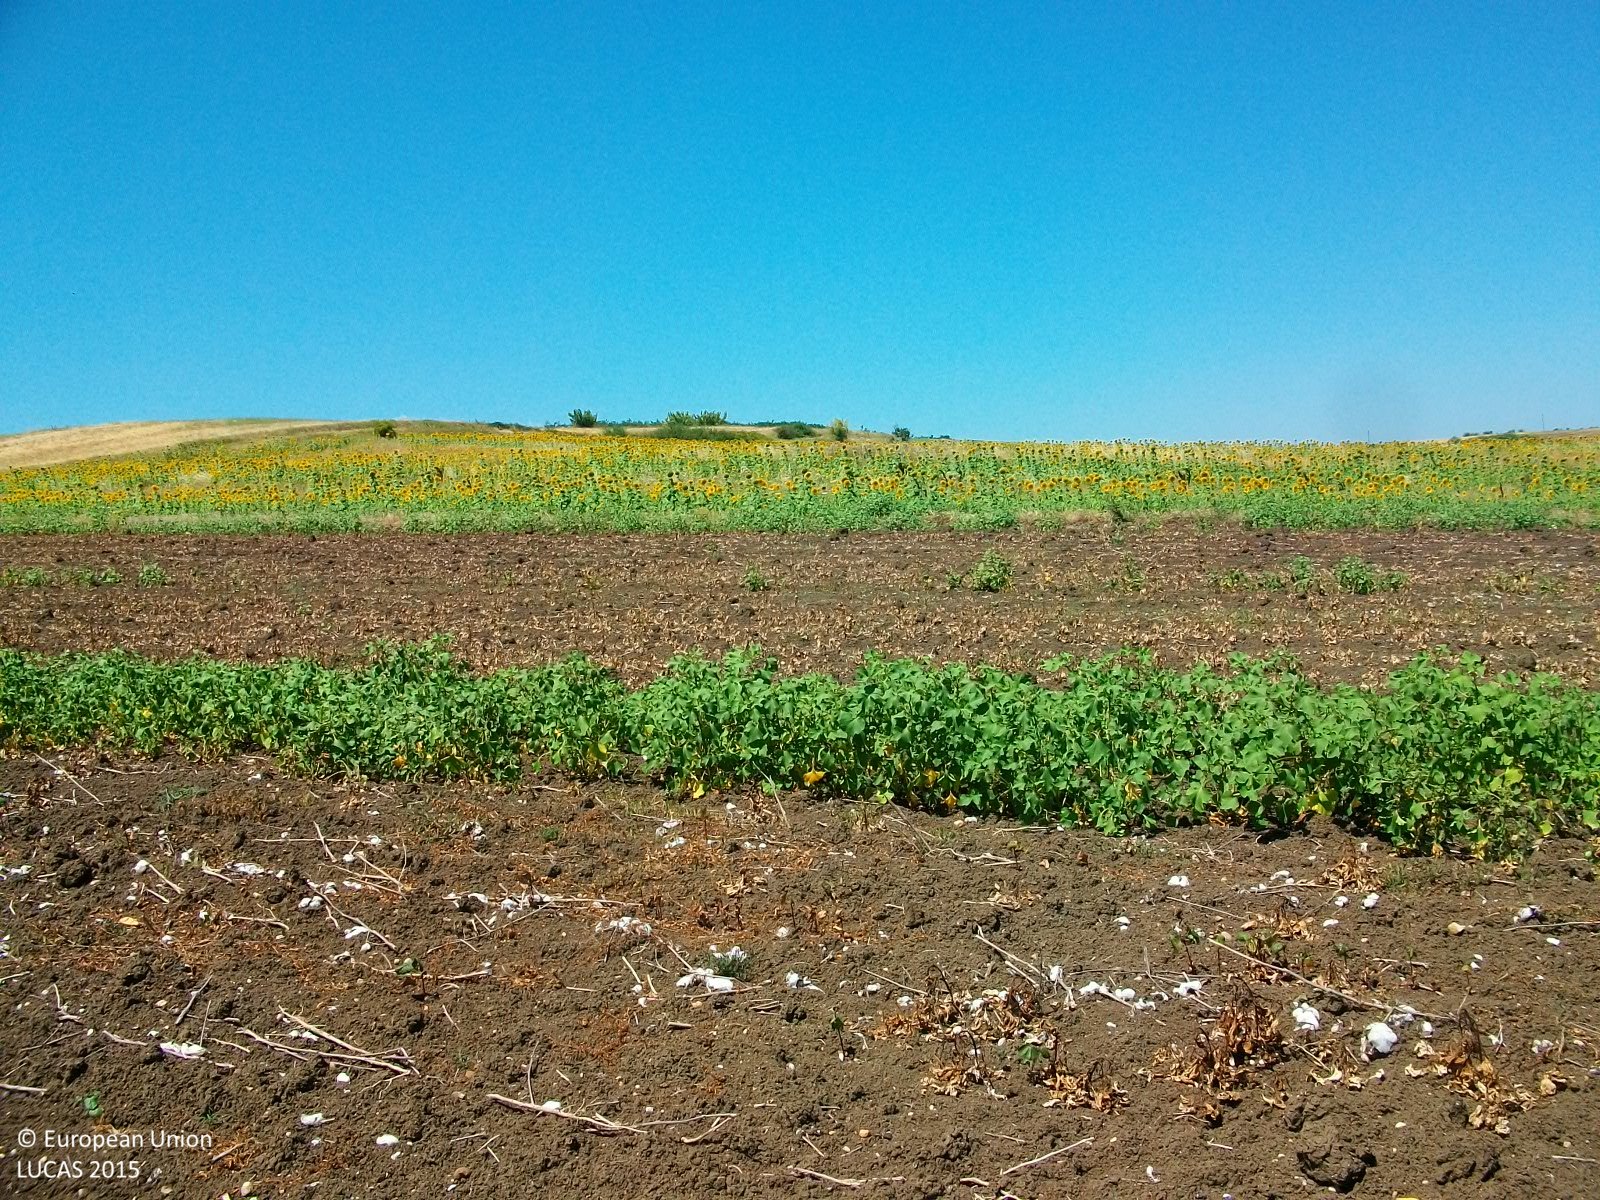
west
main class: Cropland
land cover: Cotton
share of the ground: > 75 %
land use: Agriculture (excluding fallow land and kitchen gardens)
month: July
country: GR
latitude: 41.5487
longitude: 26.2707
